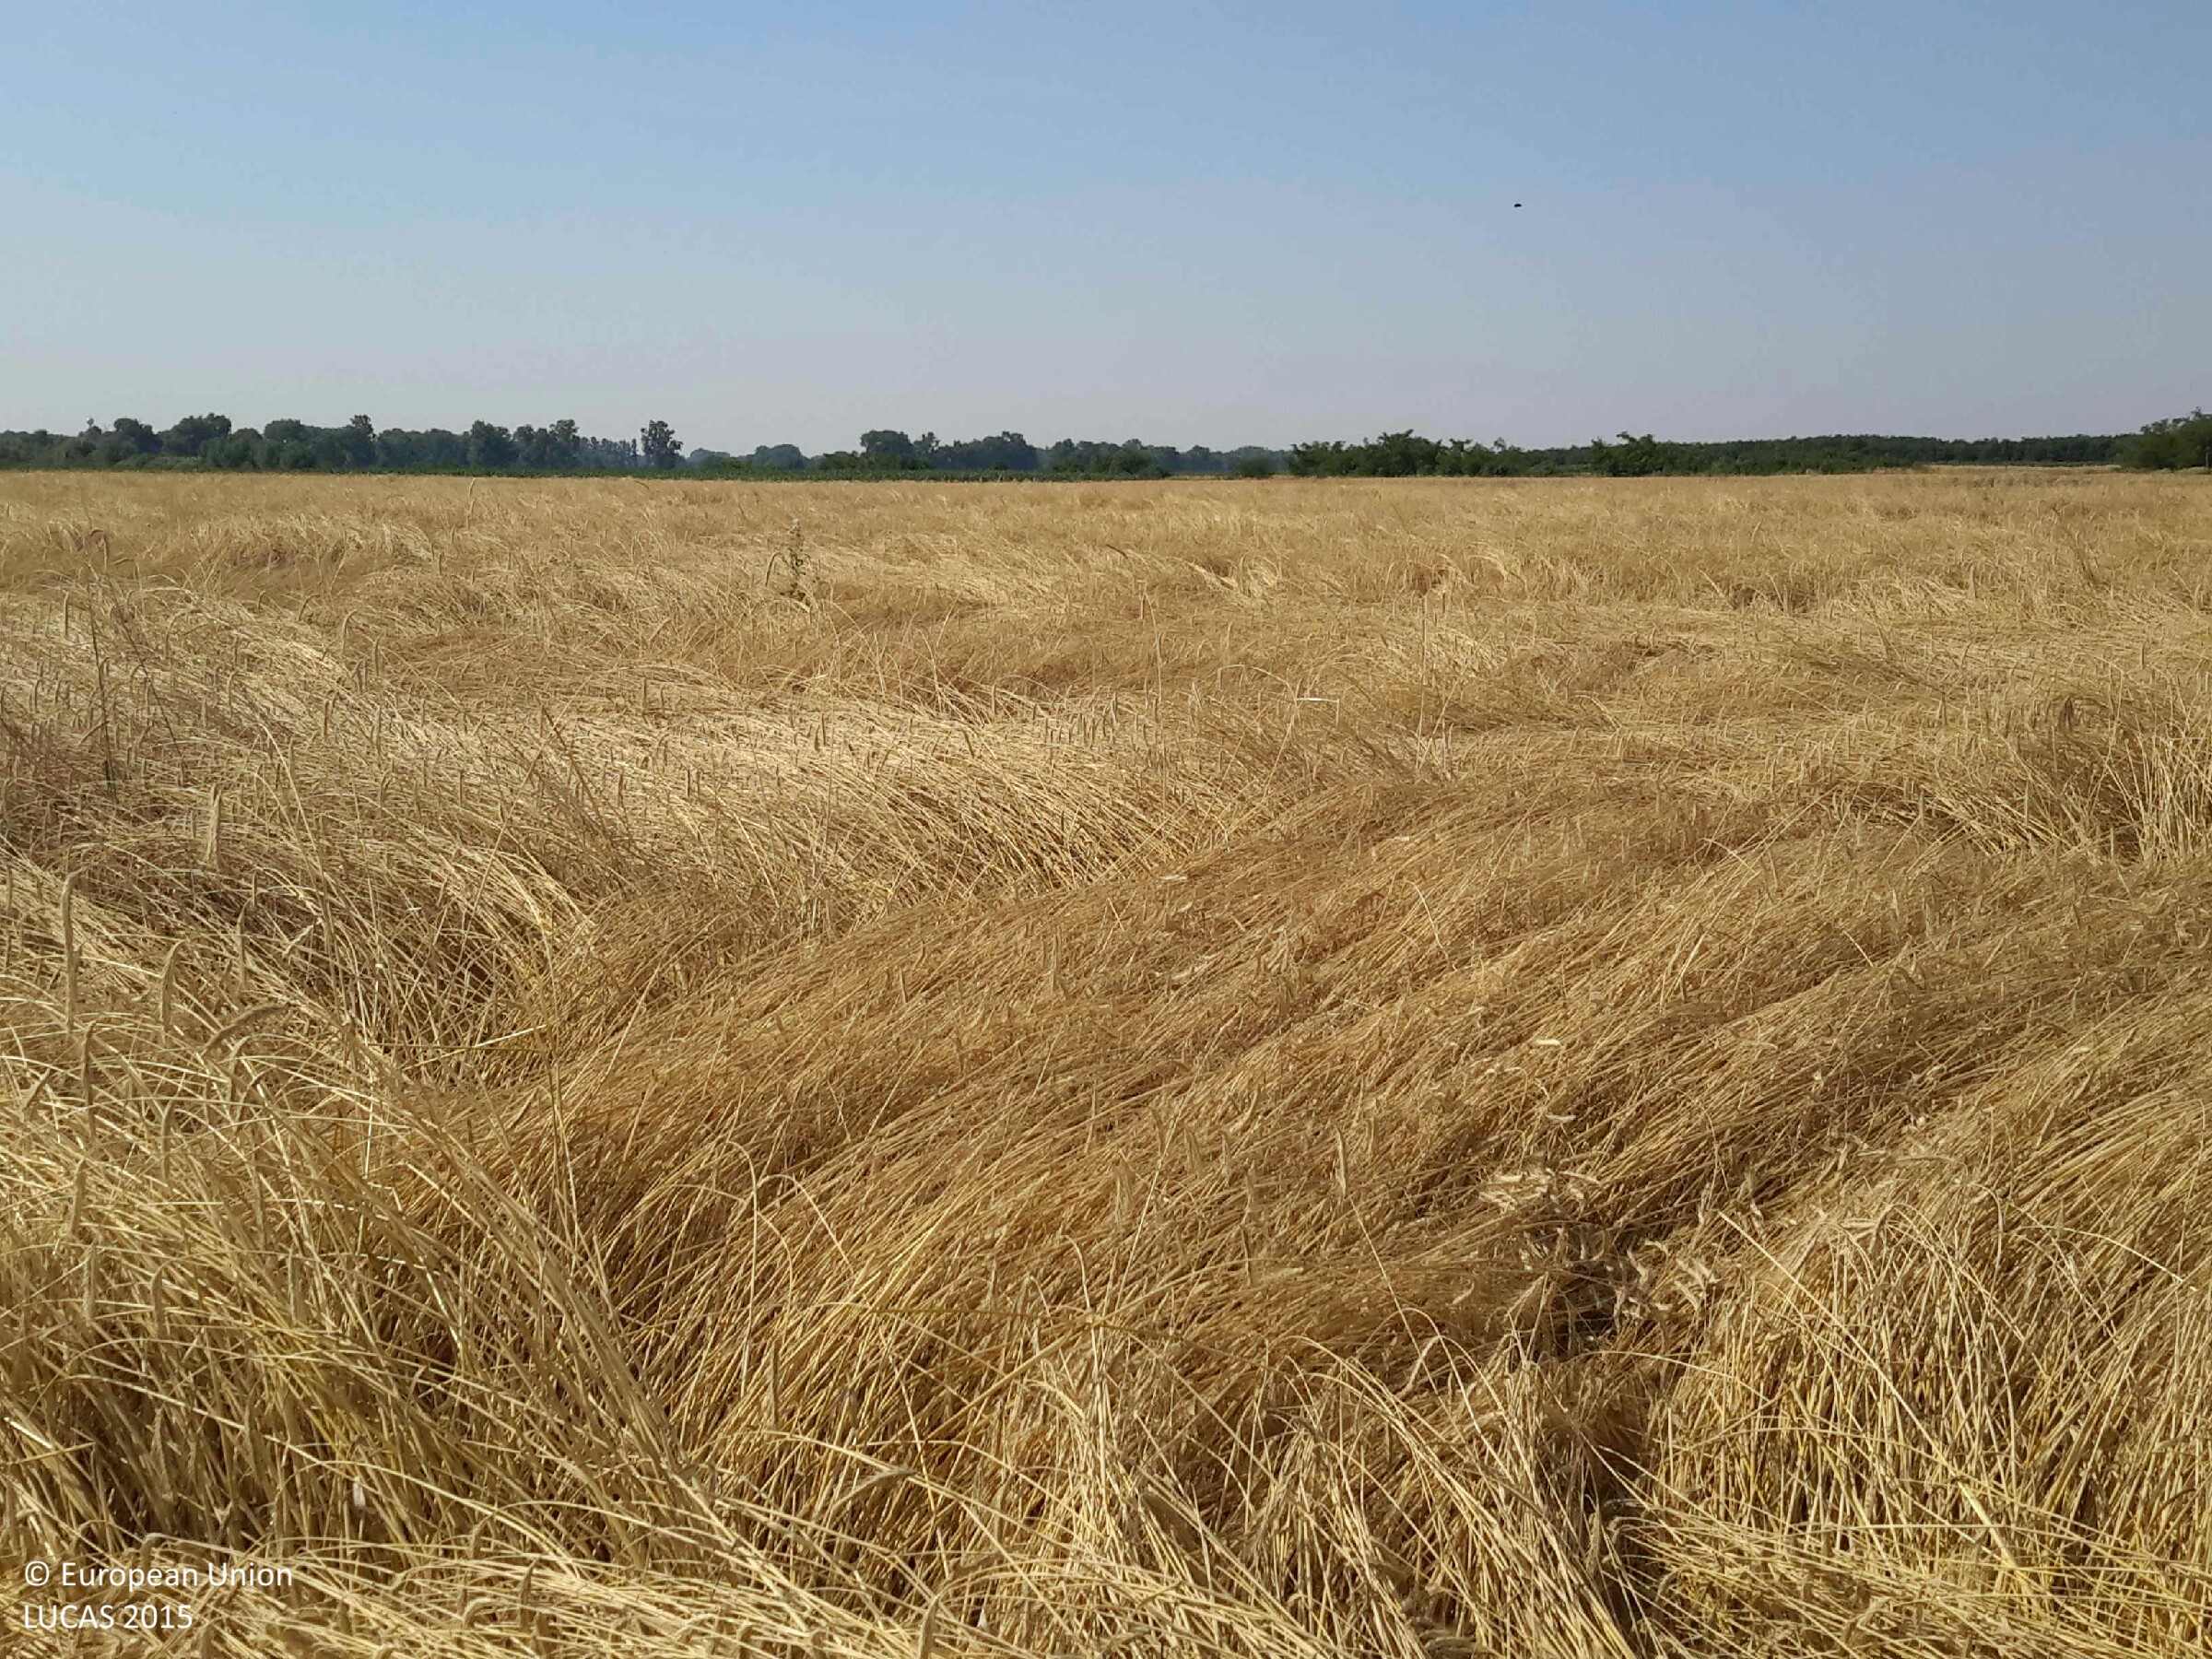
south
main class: Cropland
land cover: Common wheat
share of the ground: > 75 %
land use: Agriculture (excluding fallow land and kitchen gardens)
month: July
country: HU
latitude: 47.3184
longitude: 17.2164
